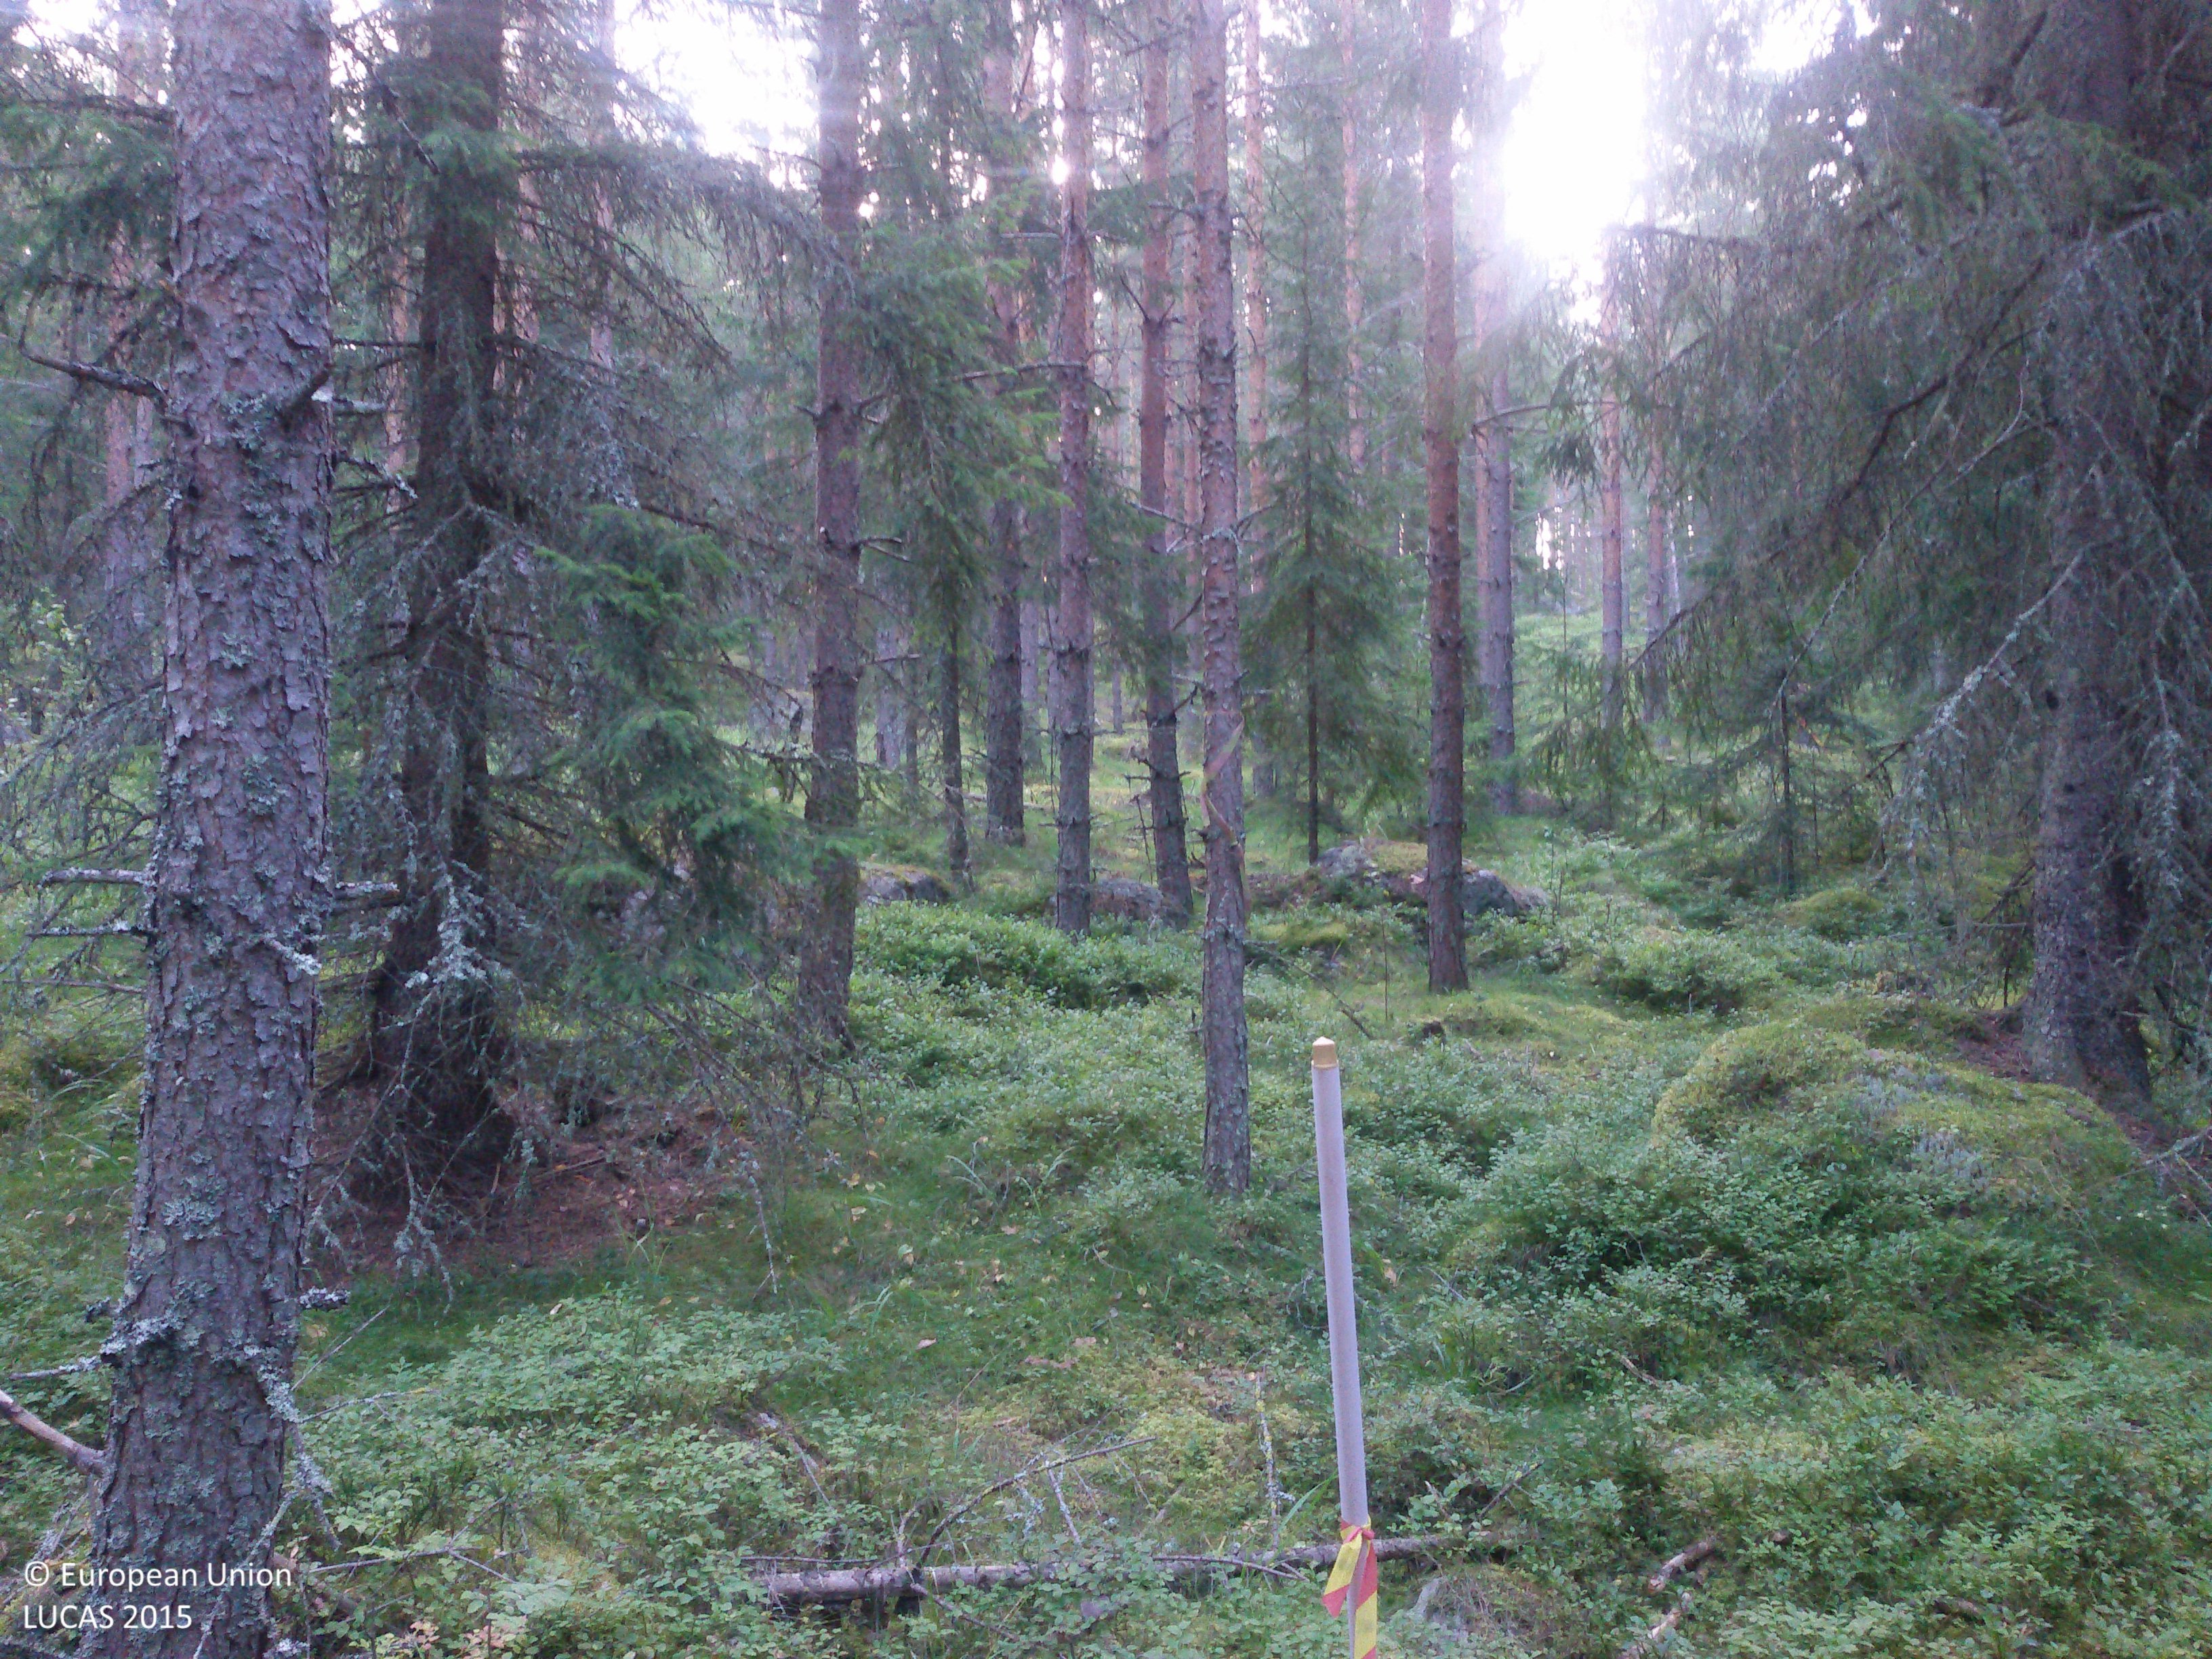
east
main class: Woodland
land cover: Pine dominated coniferous woodland
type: boreal forest
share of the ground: 50 - 75 %
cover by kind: coniferous forest trees 75 %, shrubs 10 %, lichens and mosses 10 %, herbaceous plants 5 %
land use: Forestry
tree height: > 5 m
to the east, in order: Pine dominated coniferous woodland; Spontaneously vegetated surfaces; Tracks; Spontaneously vegetated surfaces; Electric lines; Spontaneously vegetated surfaces
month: August
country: SE
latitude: 60.7236
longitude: 15.9449
